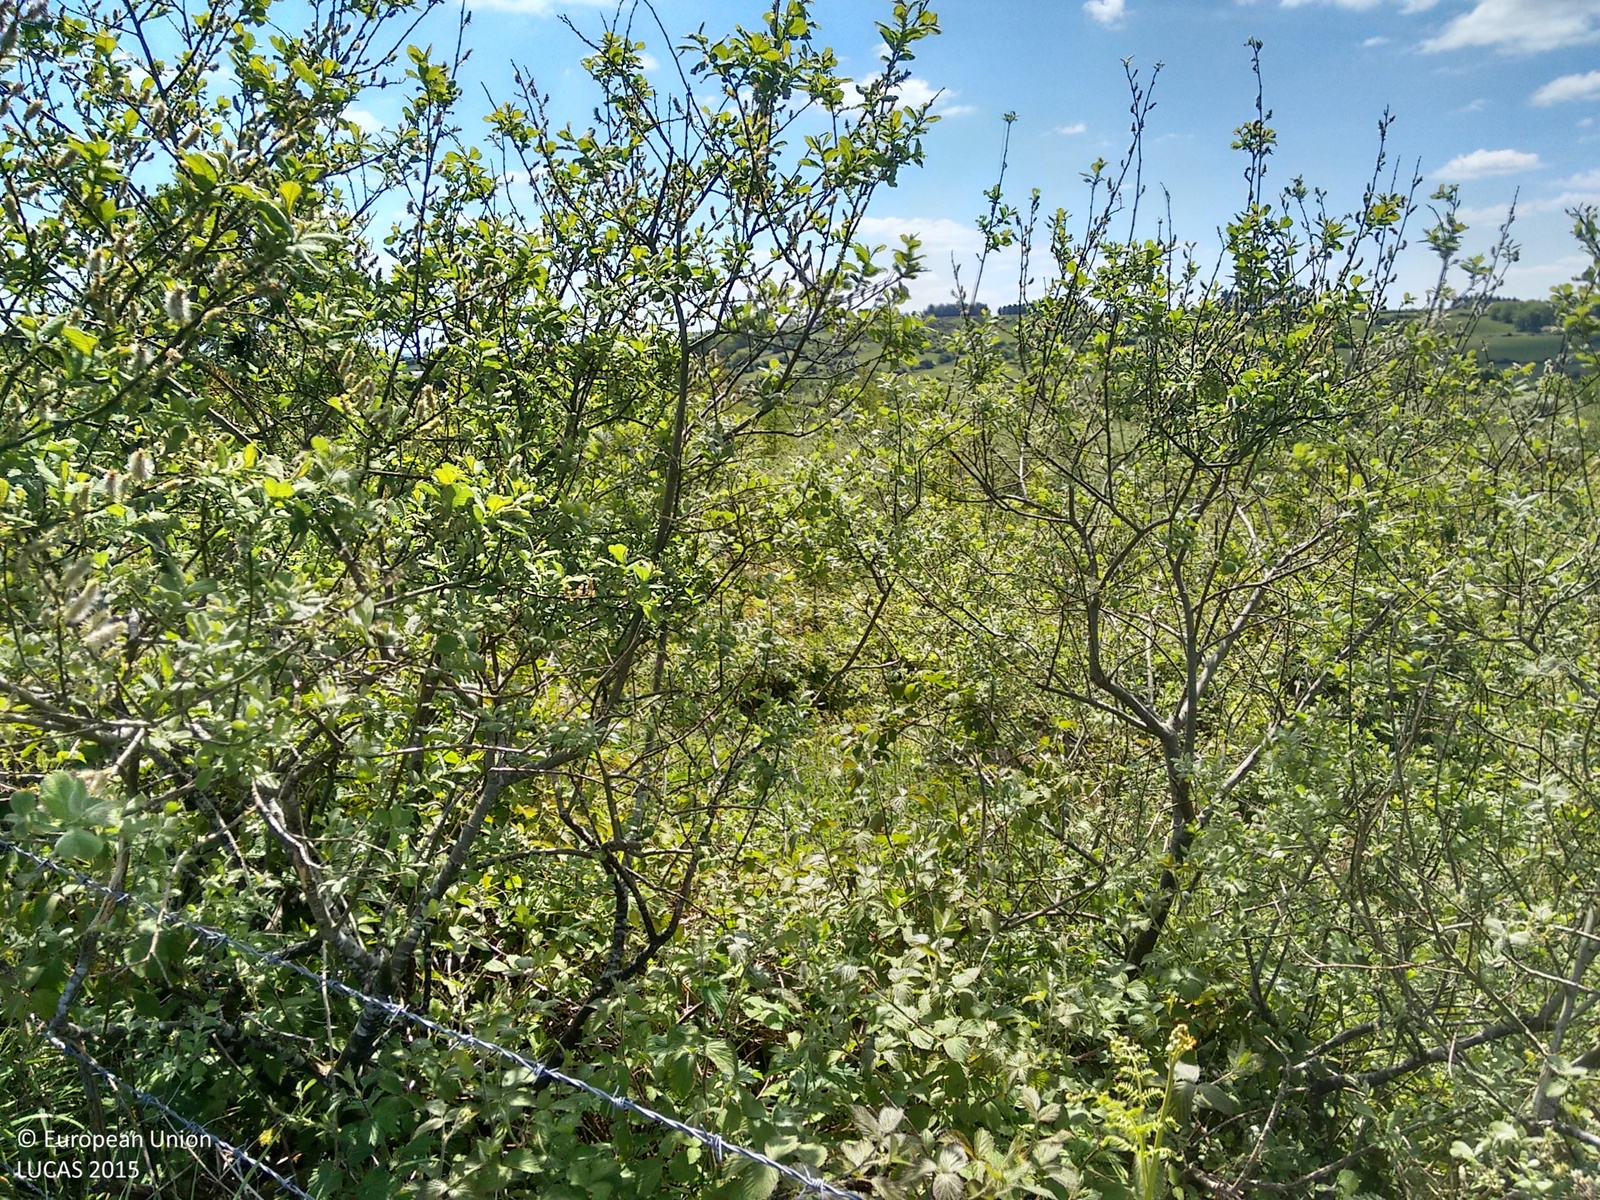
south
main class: Woodland
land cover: Broadleaved woodland
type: acidophilous oak and oak-birch forest
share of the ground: > 75 %
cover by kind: broadleaved forest trees 60 %, shrubs 20 %, herbaceous plants 20 %
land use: Forestry
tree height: < 5 m
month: June
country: IE
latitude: 52.0003
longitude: -8.8062
